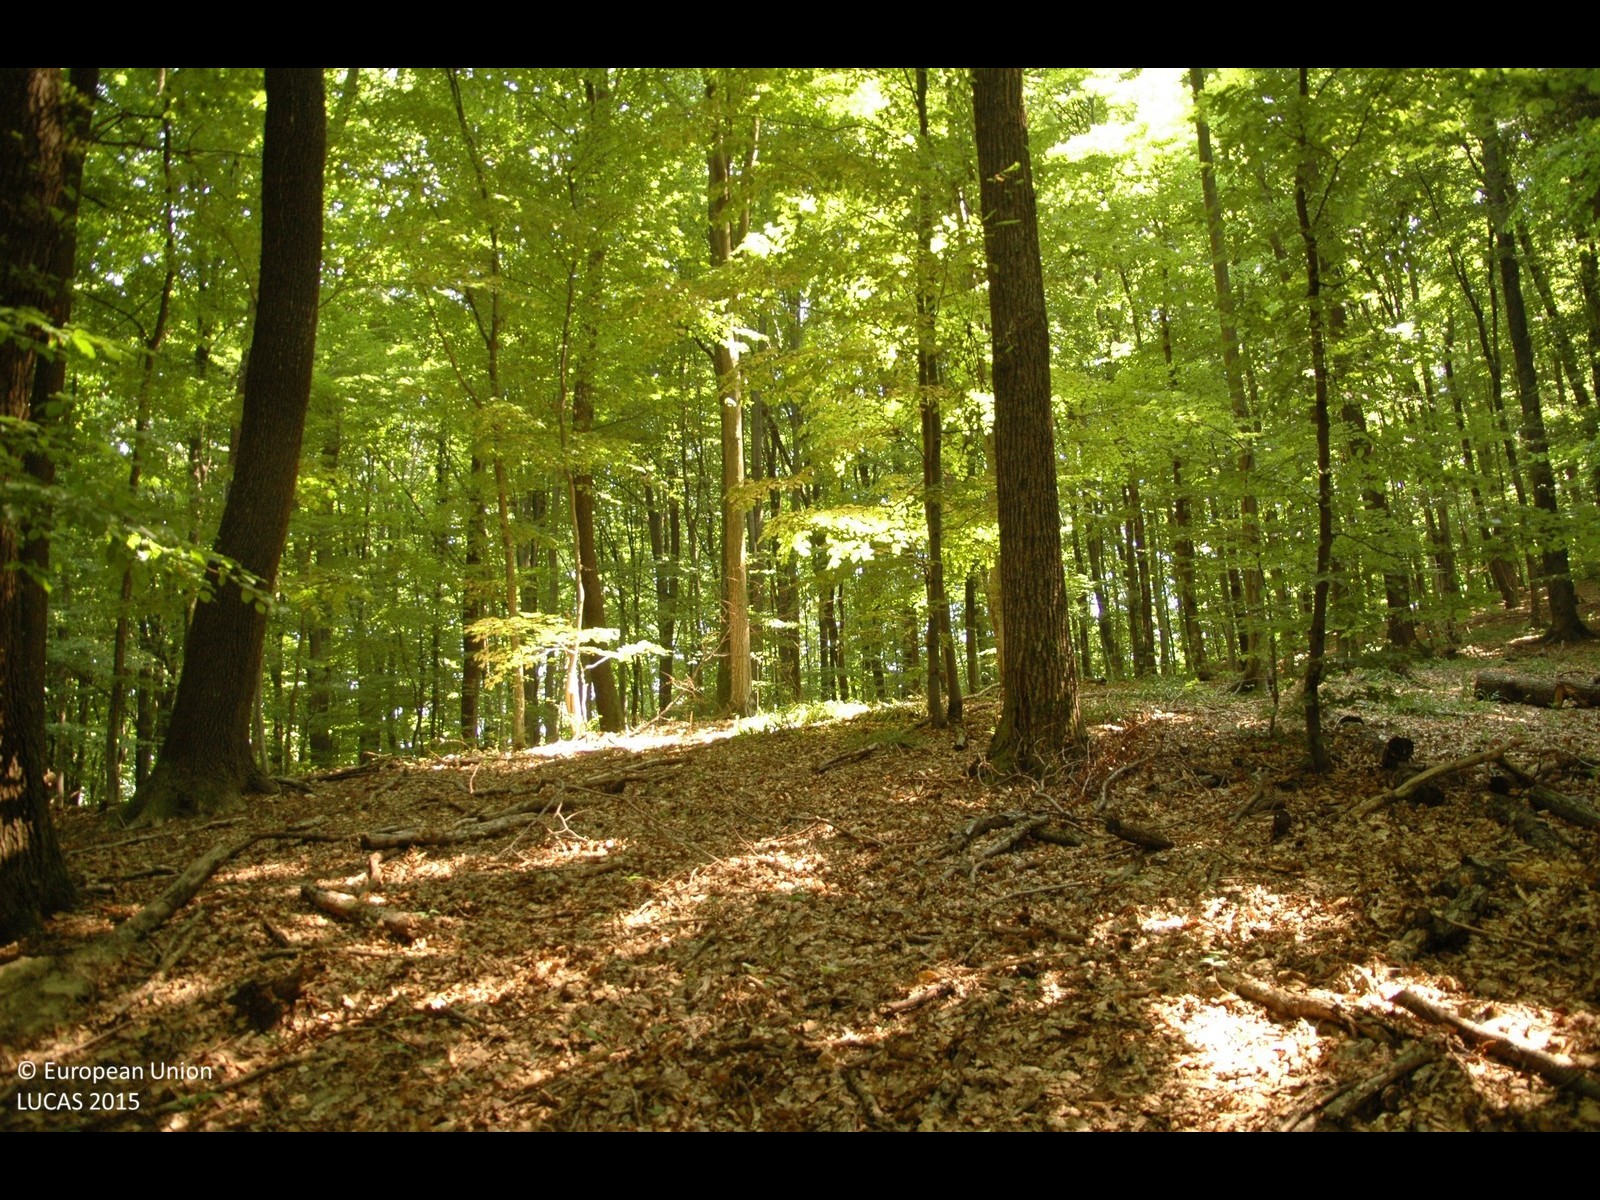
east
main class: Woodland
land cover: Broadleaved woodland
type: mesophytic deciduous forest
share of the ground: > 75 %
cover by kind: broadleaved forest trees 100 %
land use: Forestry
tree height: > 5 m
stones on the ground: < 10 %
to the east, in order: Broadleaved woodland
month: July
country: HR
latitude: 46.1674
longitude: 16.5668
